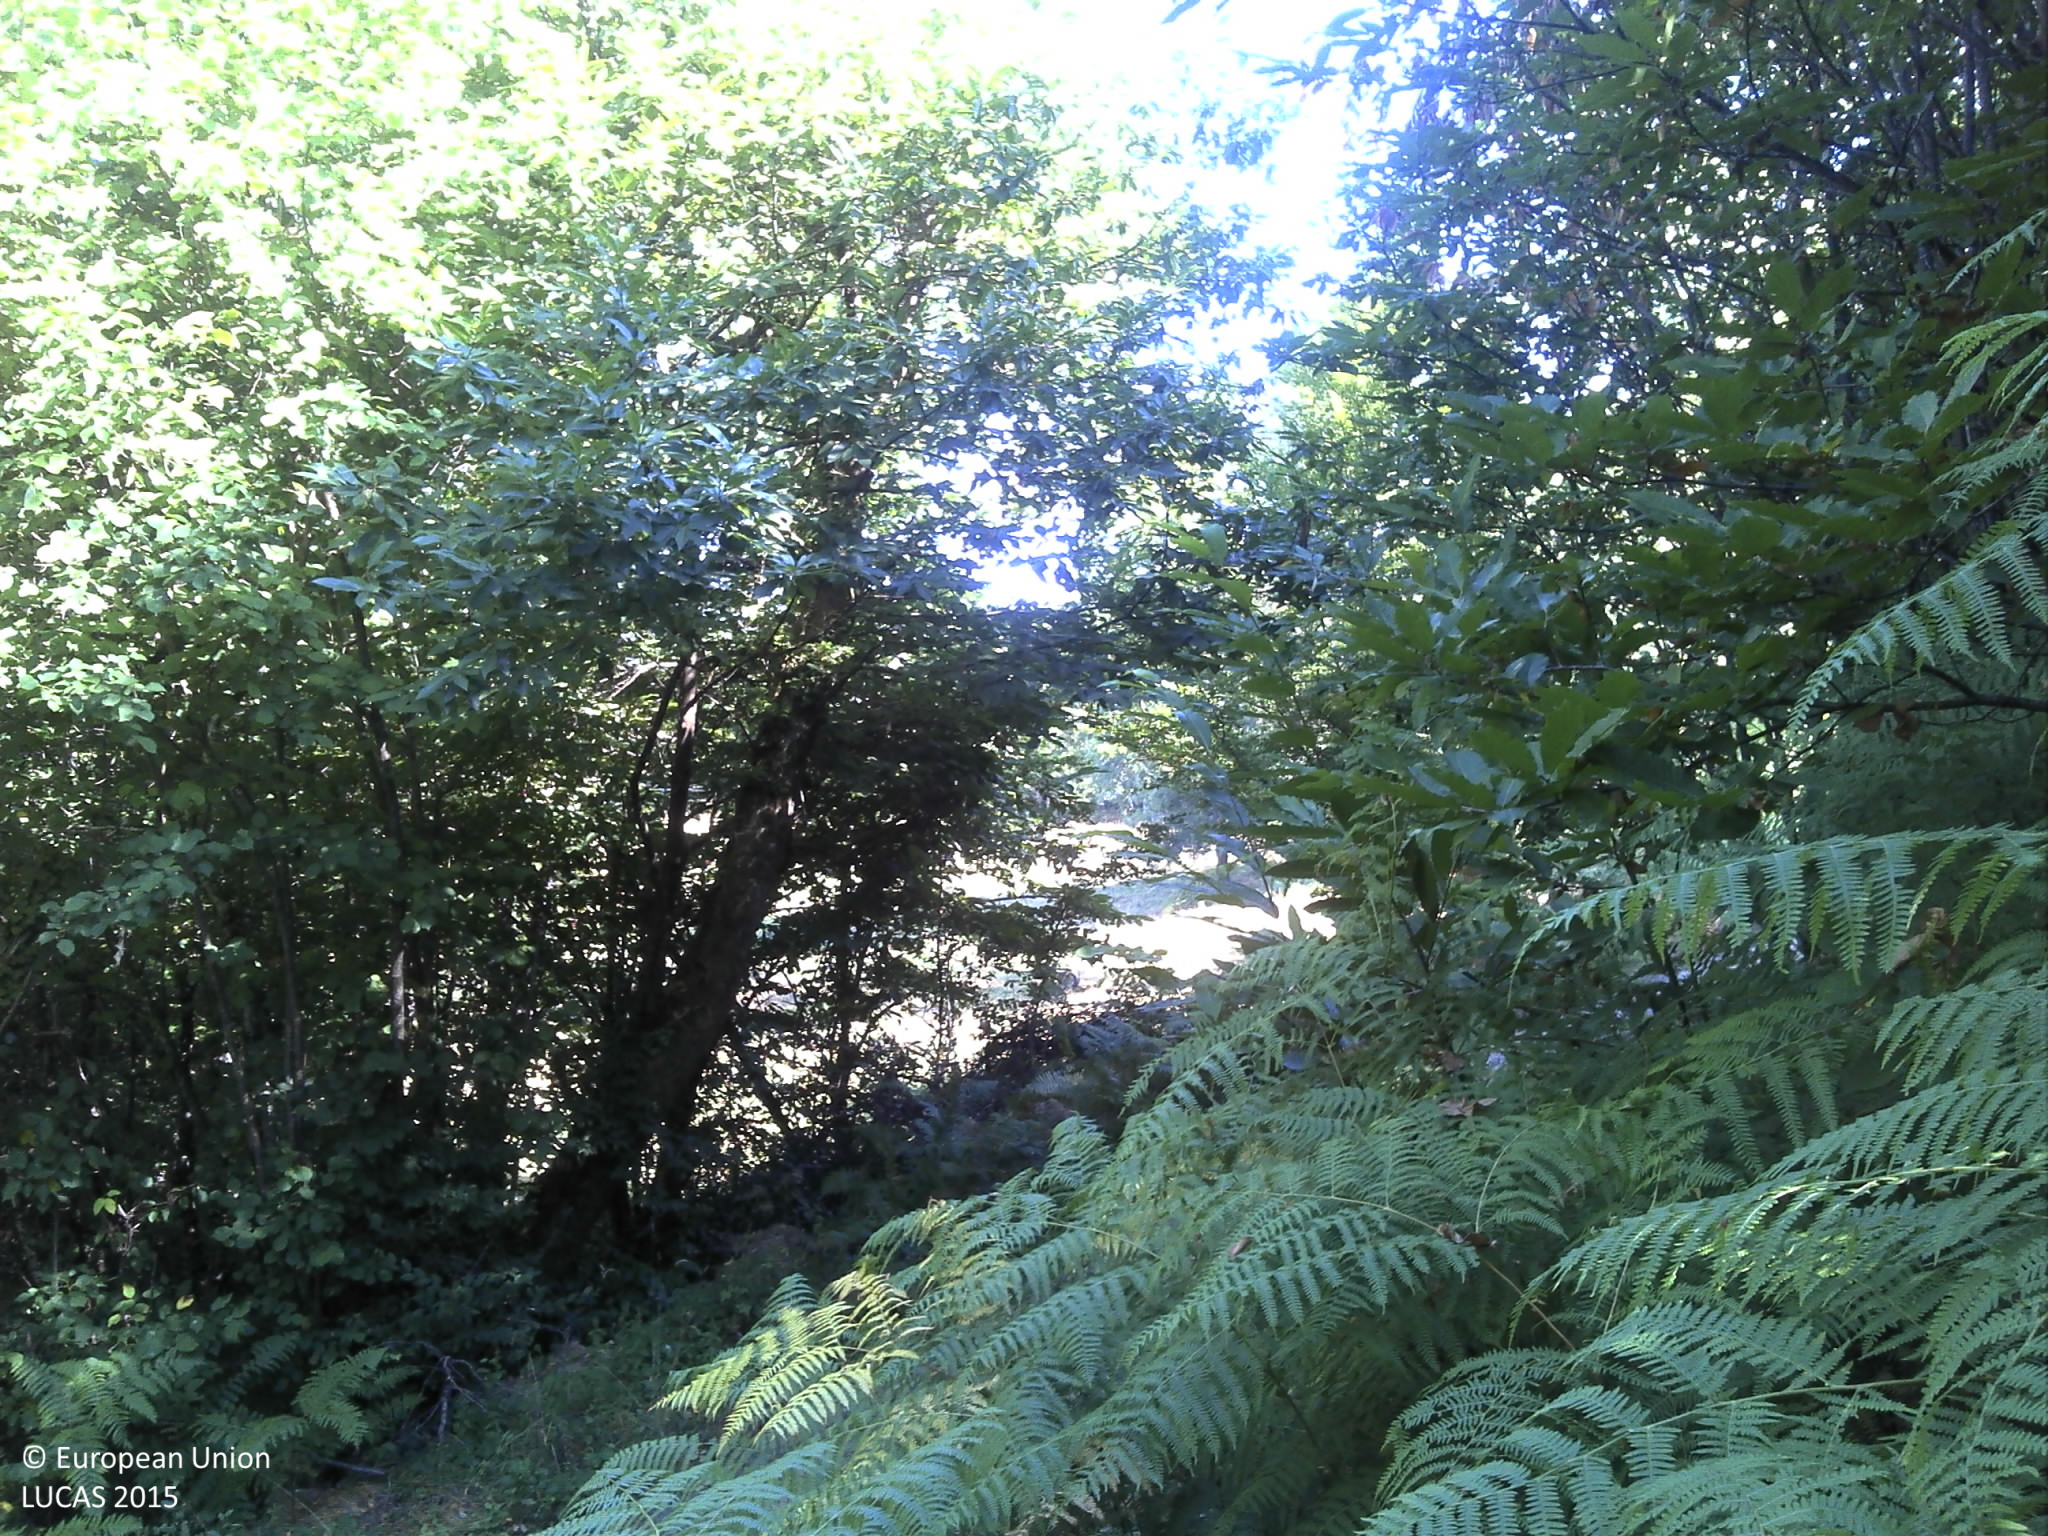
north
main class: Woodland
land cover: Broadleaved woodland
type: acidophilous oak and oak-birch forest
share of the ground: > 75 %
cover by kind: broadleaved forest trees 50 %, herbaceous plants 40 %, lichens and mosses 5 %, unconsolidated bare surface 5 %
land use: Forestry
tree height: > 5 m
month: July
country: FR
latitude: 45.0767
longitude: 1.8038
